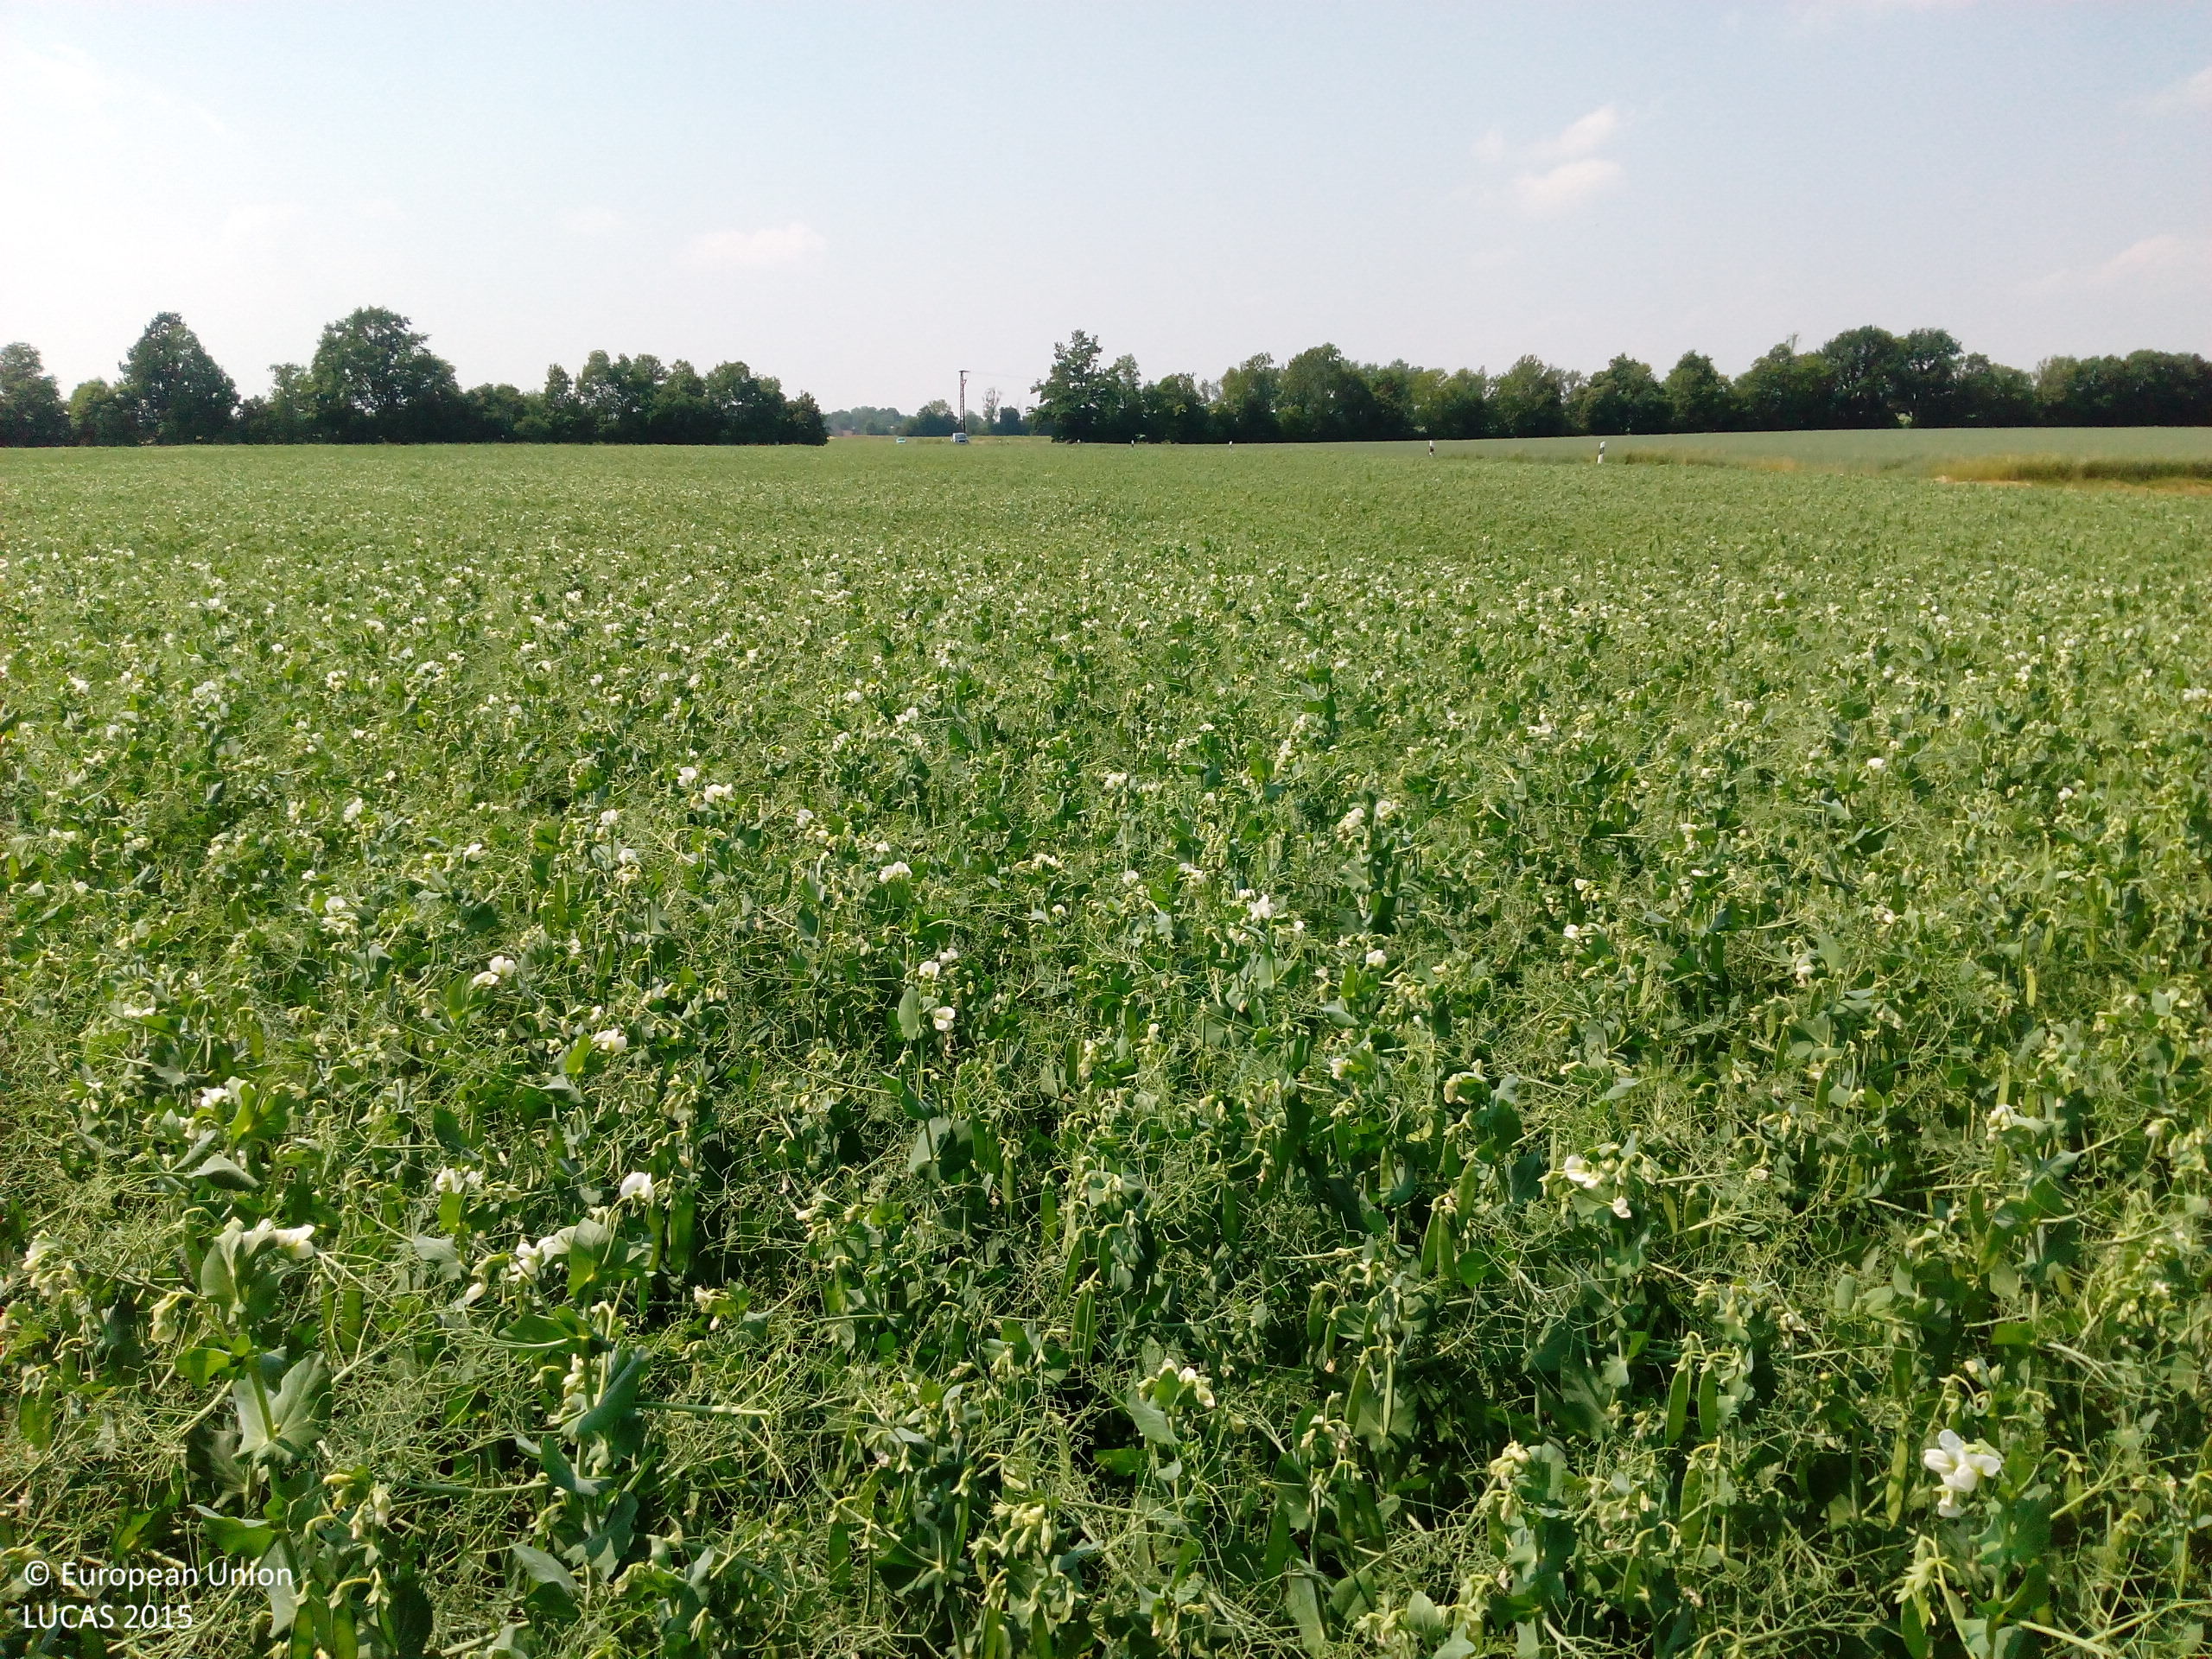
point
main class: Cropland
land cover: Dry pulses
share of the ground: > 75 %
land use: Agriculture (excluding fallow land and kitchen gardens)
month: June
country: DE
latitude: 51.4330
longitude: 12.5458
